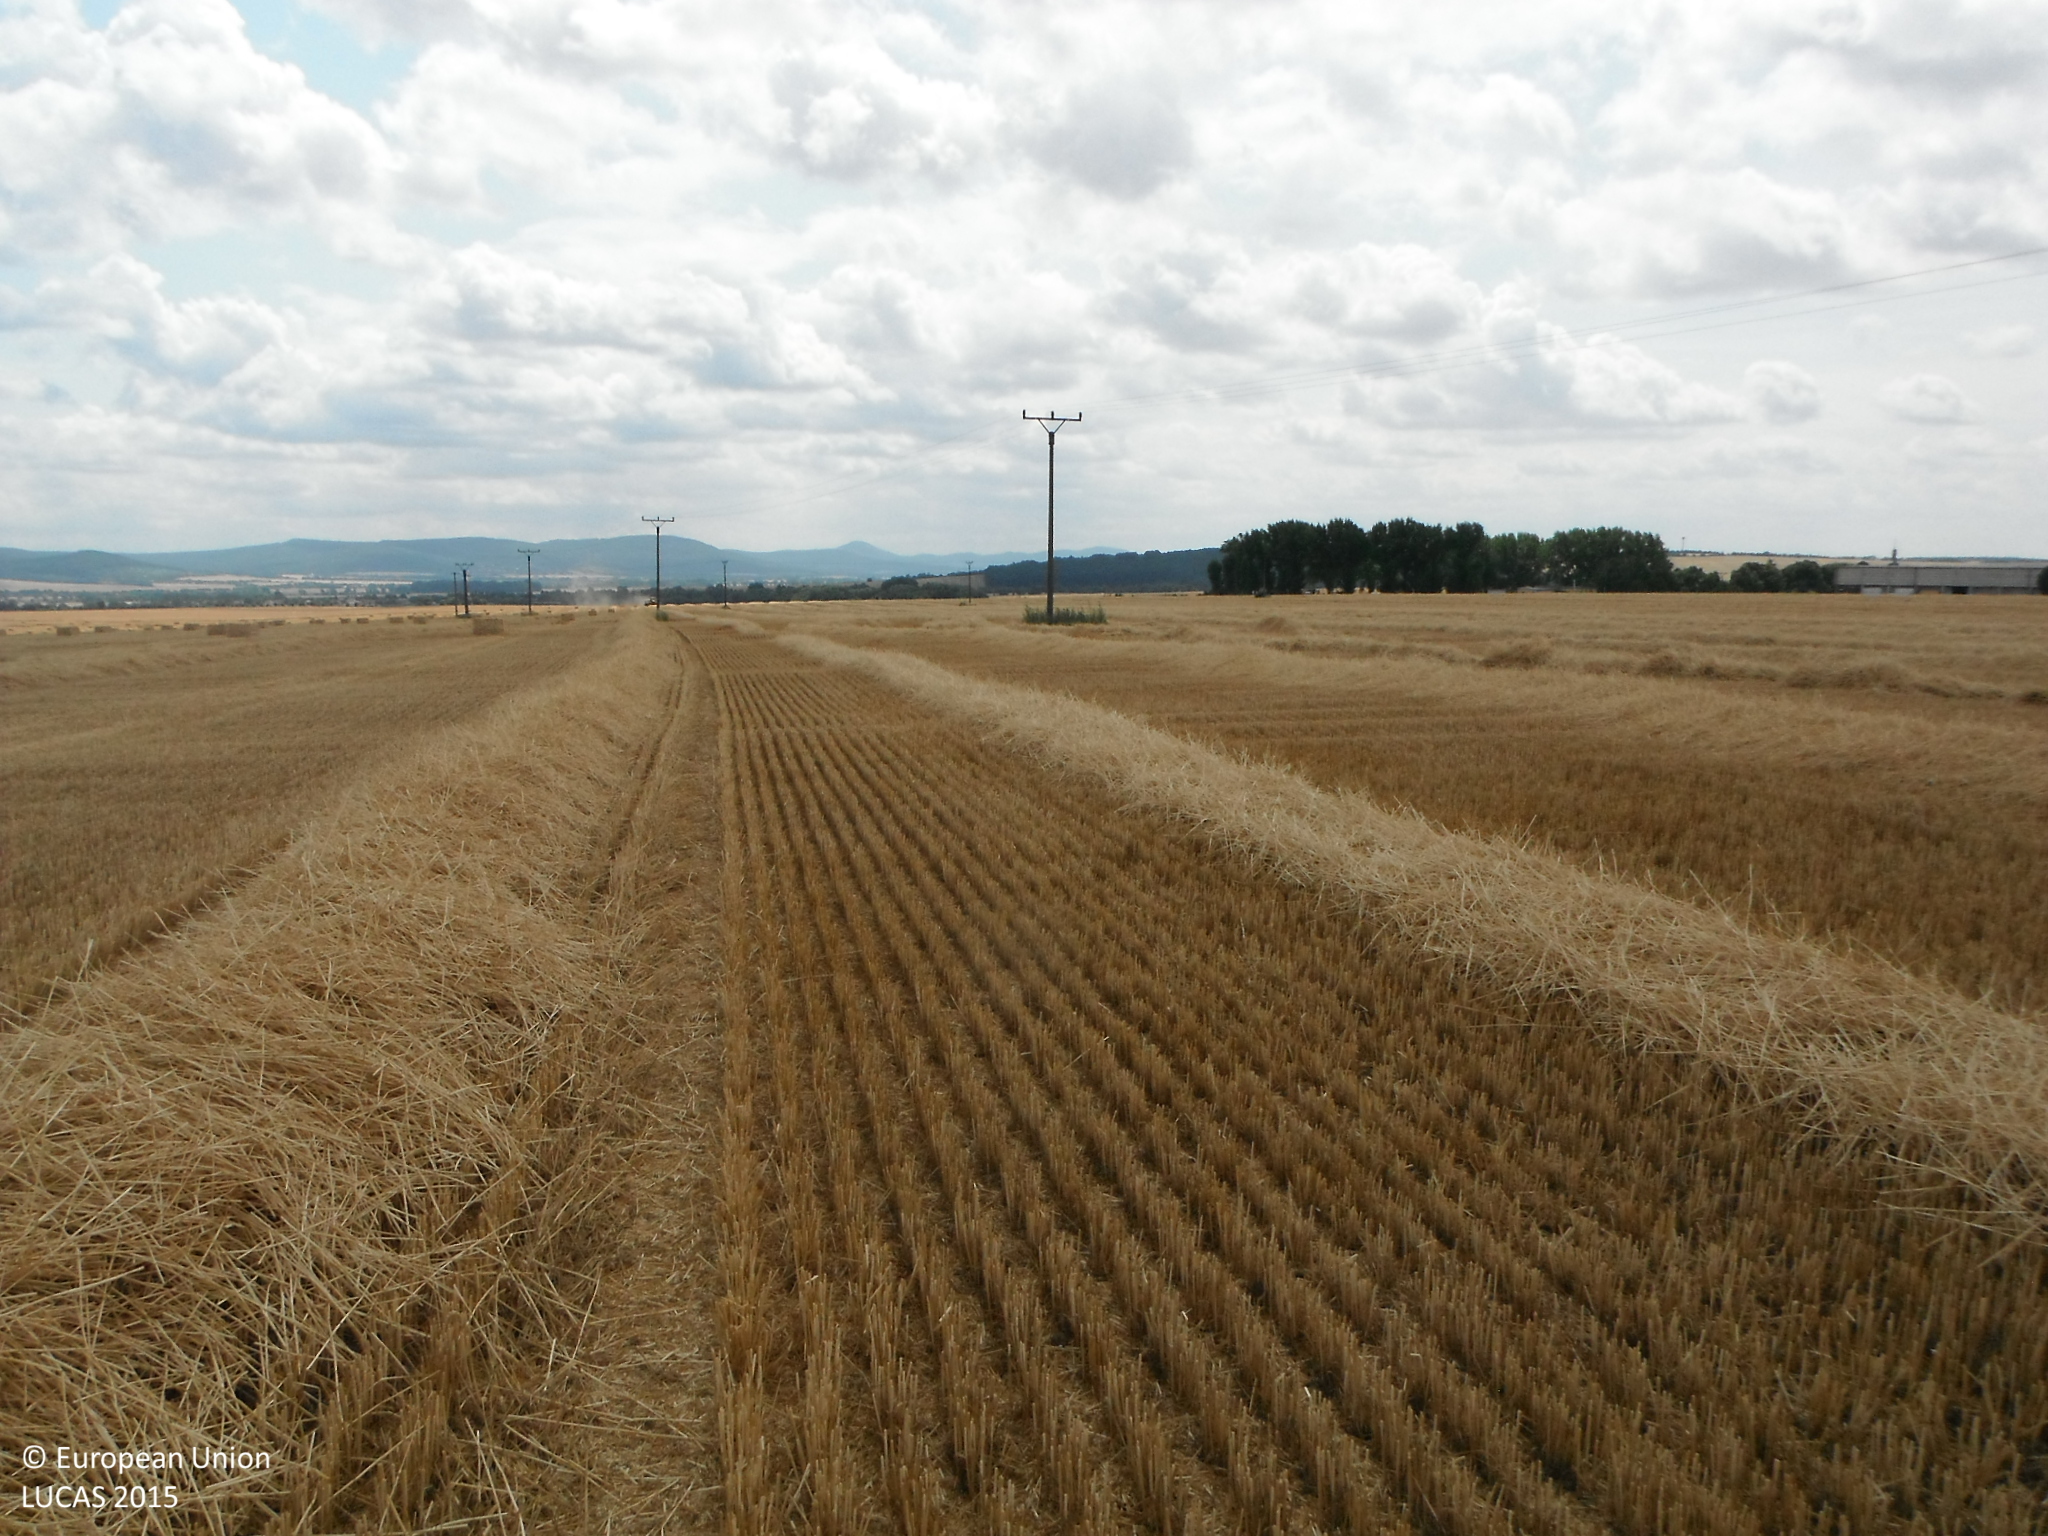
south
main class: Cropland
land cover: Common wheat
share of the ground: > 75 %
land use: Agriculture (excluding fallow land and kitchen gardens)
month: July
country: SK
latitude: 48.5558
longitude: 18.1301
